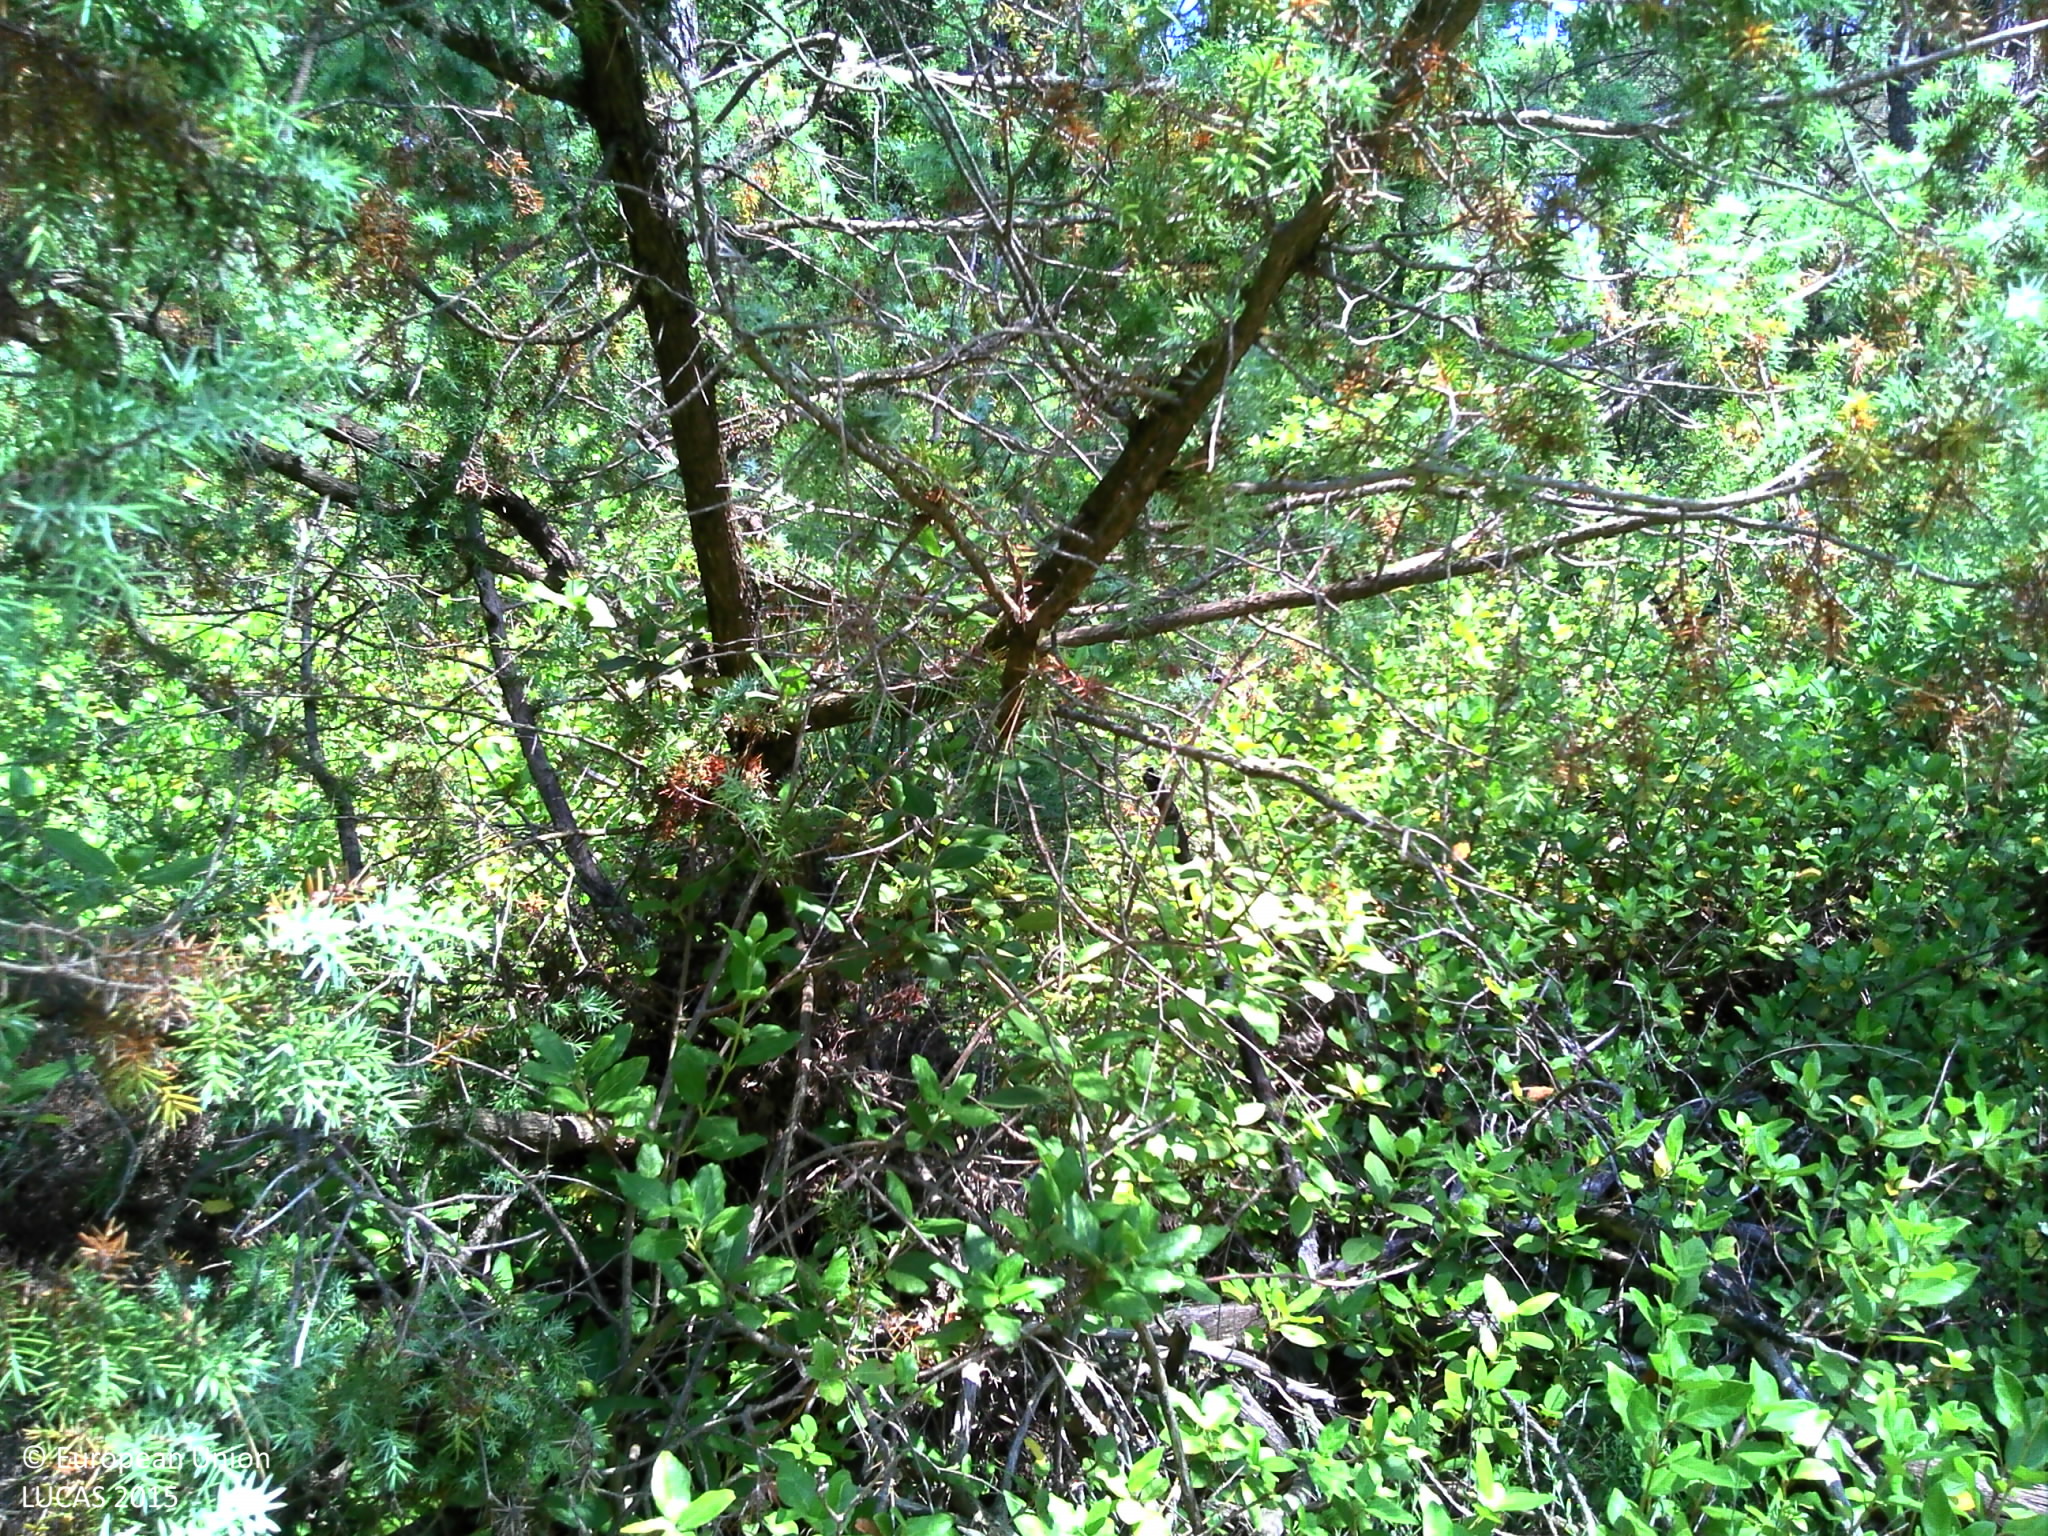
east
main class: Woodland
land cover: Pine dominated mixed woodland
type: coniferous forest of the mediterranean region
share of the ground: 50 - 75 %
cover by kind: coniferous forest trees 40 %, broadleaved forest trees 30 %, shrubs 20 %, herbaceous plants 5 %, lichens and mosses 5 %
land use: Forestry
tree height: > 5 m
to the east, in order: Pine dominated mixed woodland; Shrubland with sparse tree cover; Pine dominated mixed woodland
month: July
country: FR
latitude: 44.0218
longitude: 5.1804
